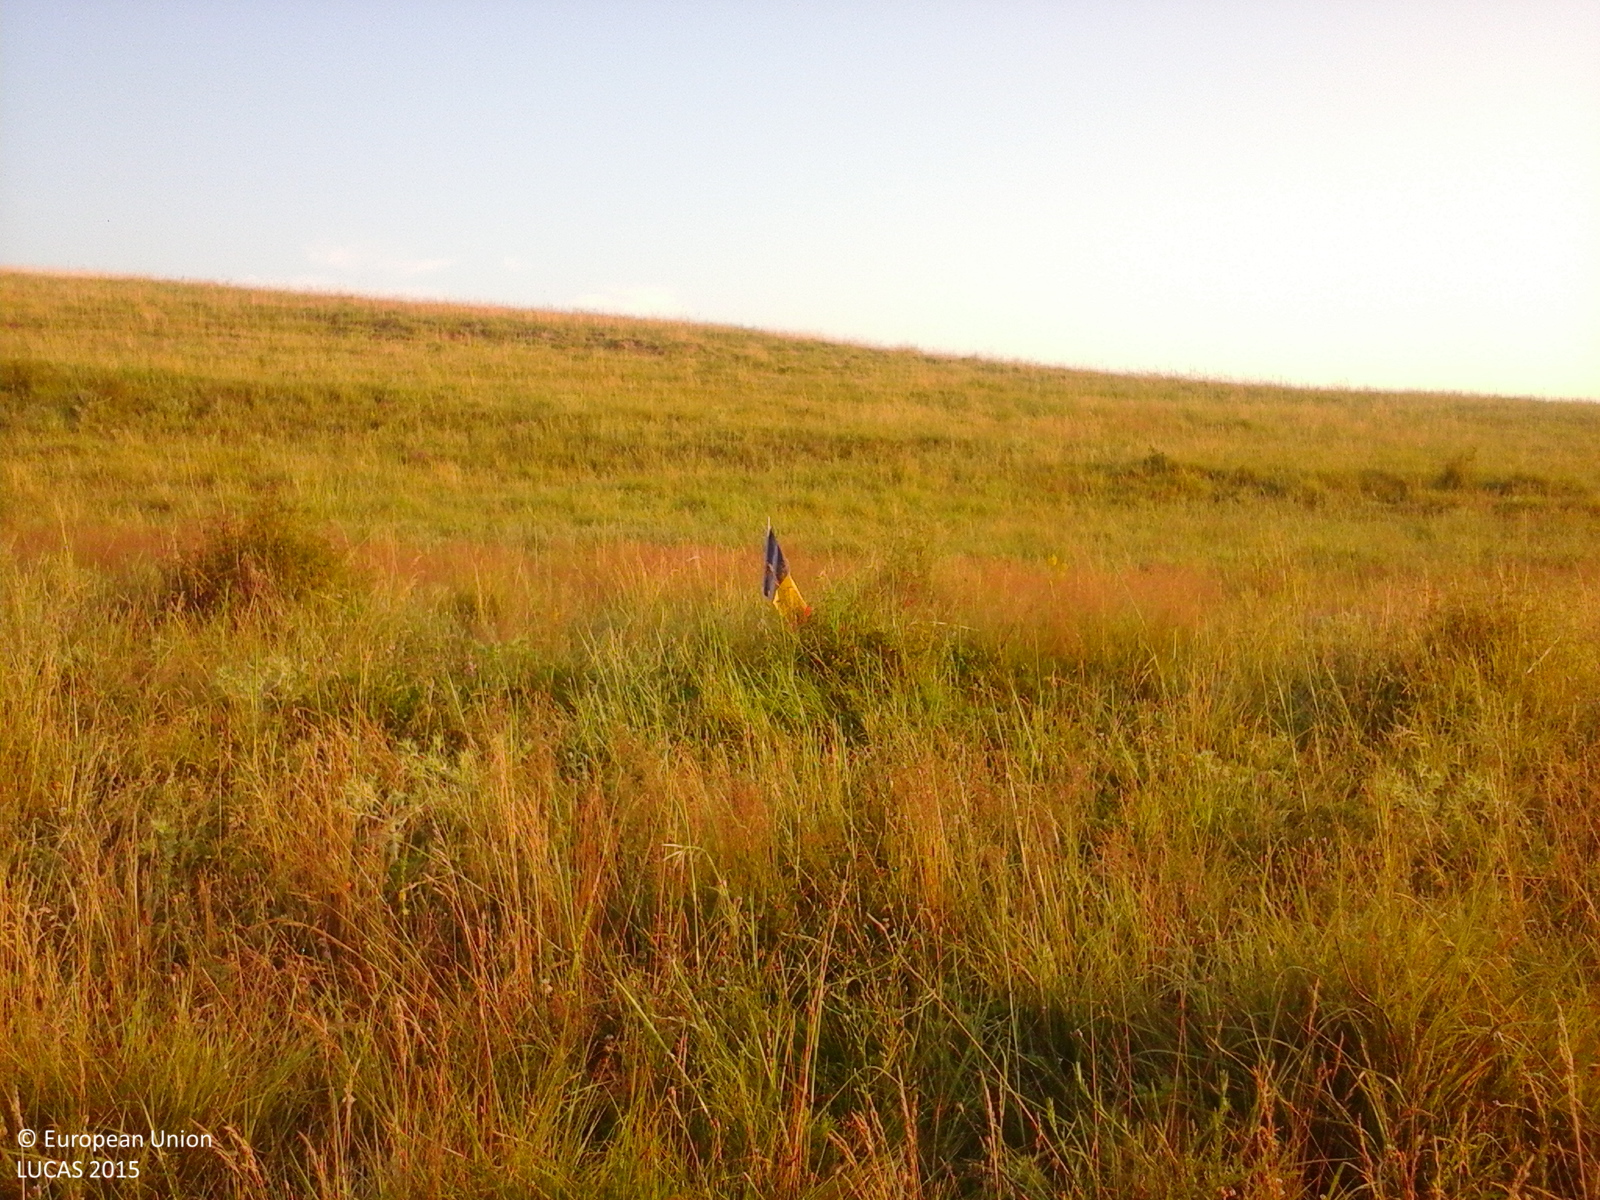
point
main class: Grassland
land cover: Grassland with sparse tree/shrub cover
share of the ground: > 75 %
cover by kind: herbaceous plants 85 %, shrubs 10 %, broadleaved forest trees 5 %
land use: Agriculture (excluding fallow land and kitchen gardens)
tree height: < 5 m
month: July
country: RO
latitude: 44.6141
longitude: 24.7066
